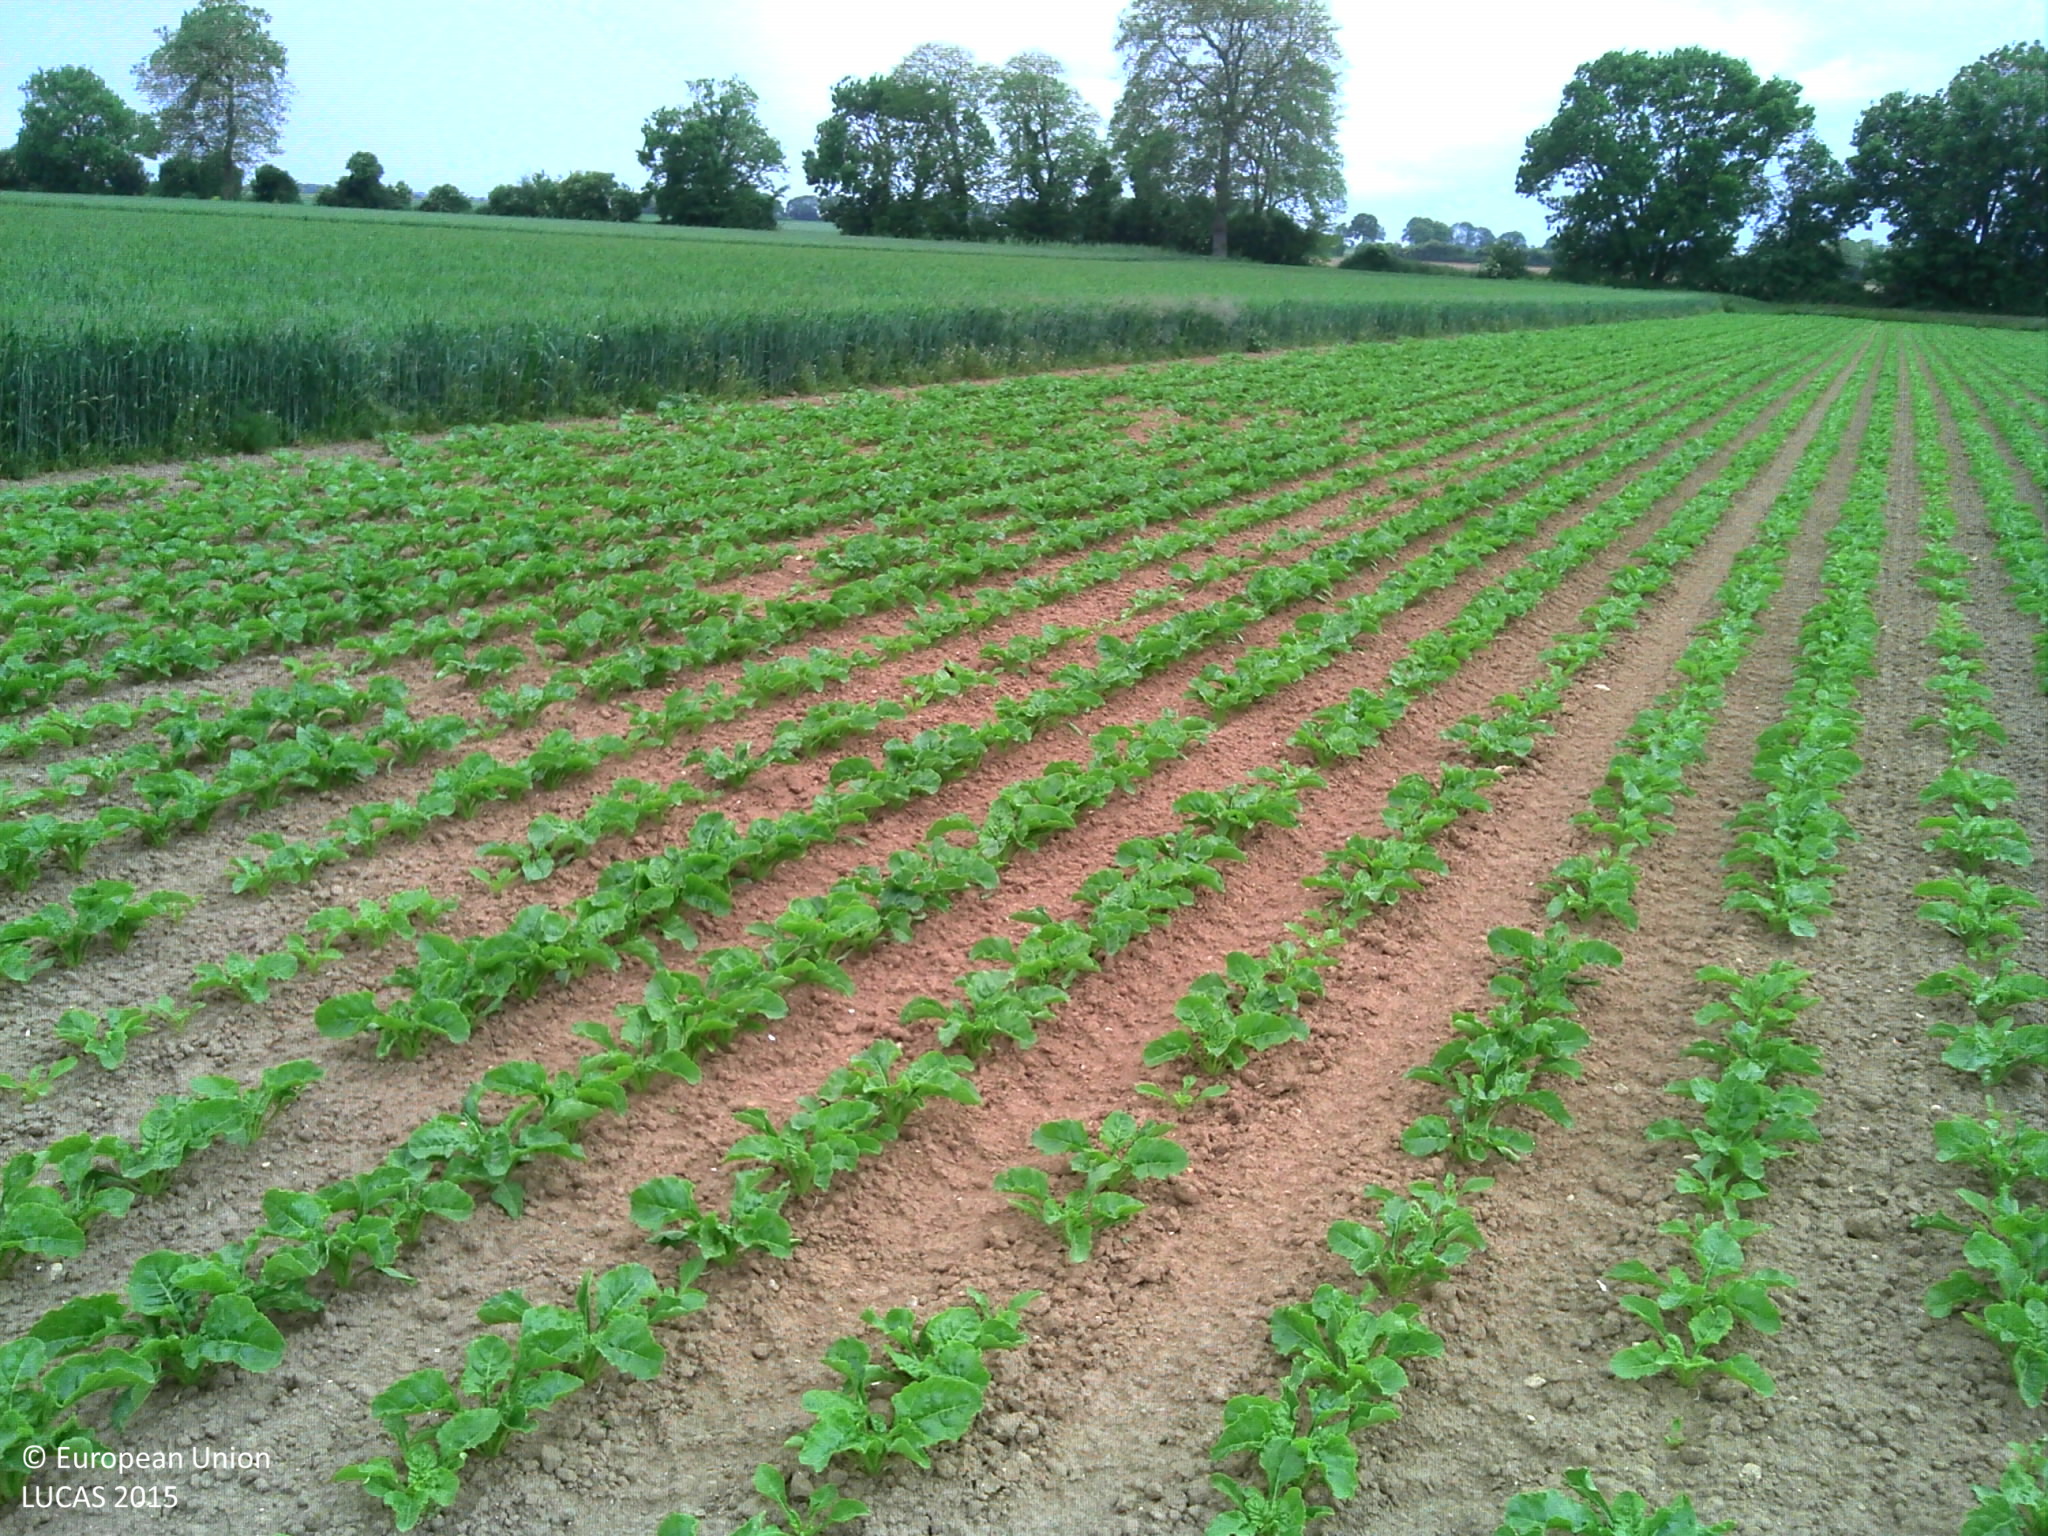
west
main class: Cropland
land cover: Sugar beet
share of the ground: 25 - 50 %
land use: Agriculture (excluding fallow land and kitchen gardens)
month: May
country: FR
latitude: 49.2963
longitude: -0.3341
